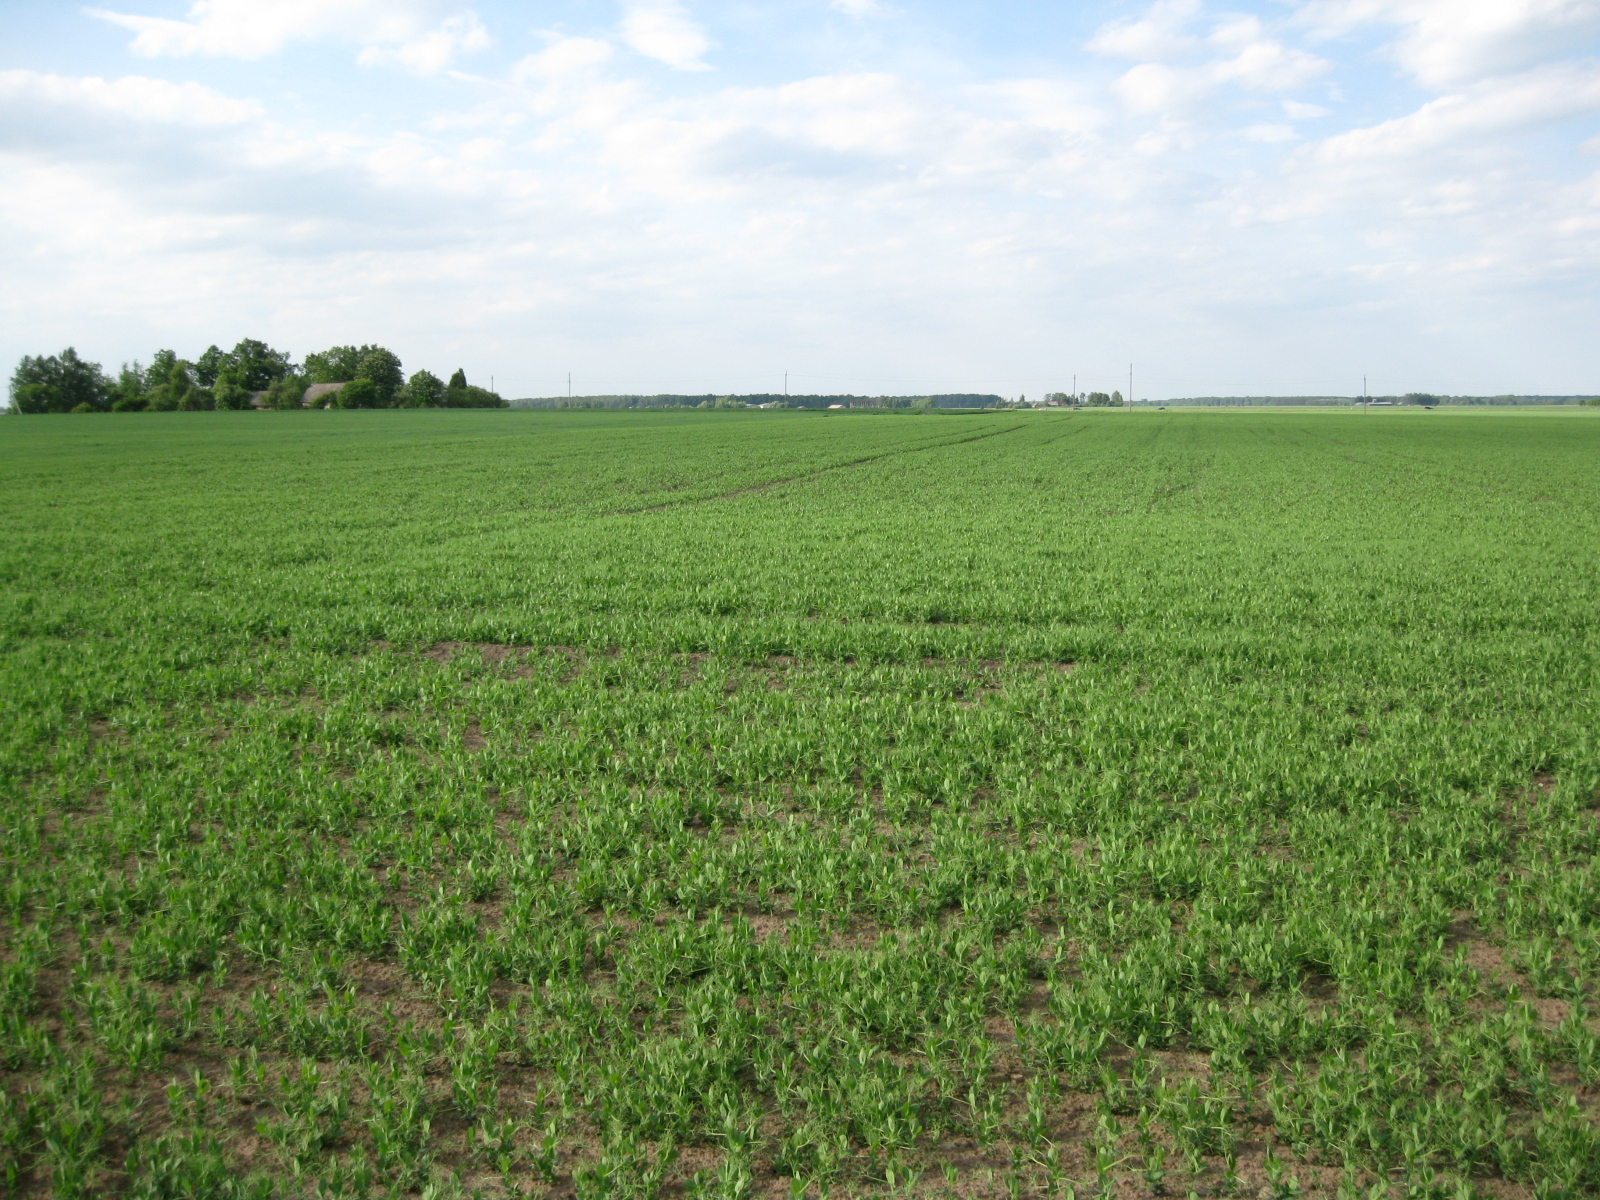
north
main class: Cropland
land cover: Dry pulses
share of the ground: 50 - 75 %
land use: Agriculture (excluding fallow land and kitchen gardens)
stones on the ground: < 10 %
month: June
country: LT
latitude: 55.7517
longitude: 24.0950
